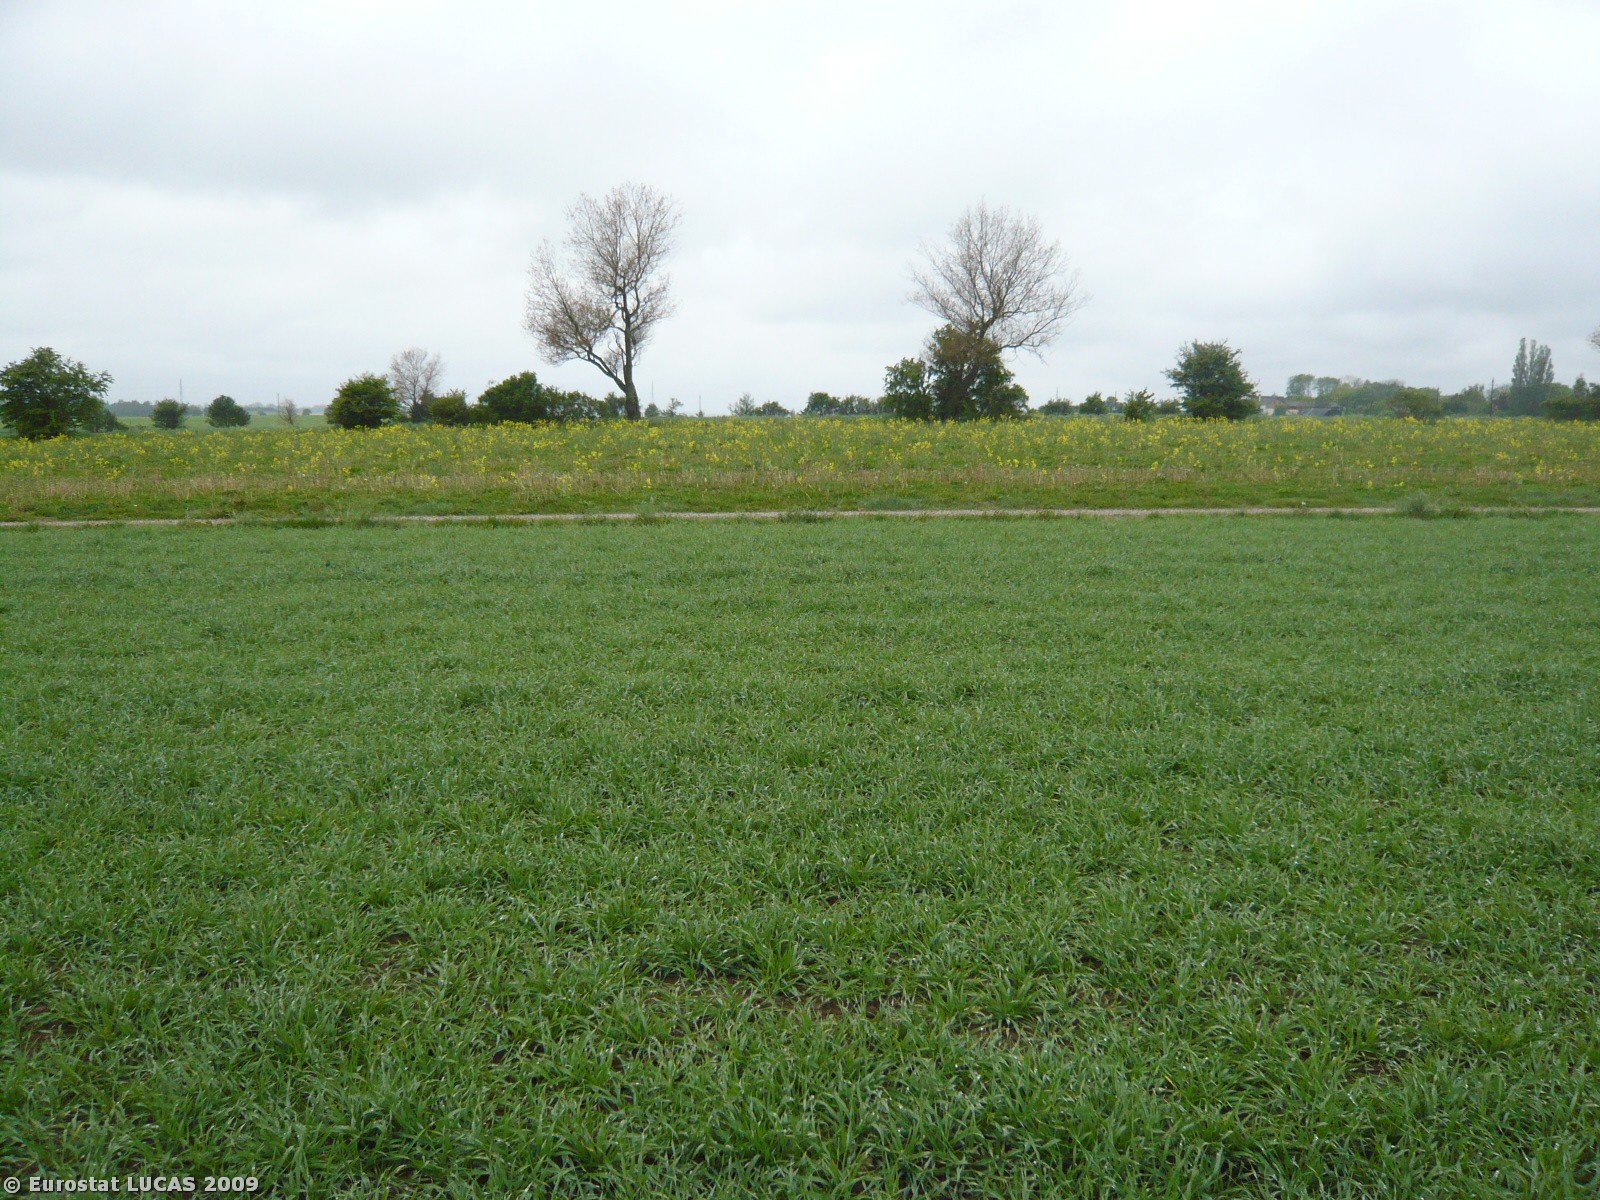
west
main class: Cropland
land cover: Barley
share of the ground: > 75 %
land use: Agriculture (excluding fallow land and kitchen gardens)
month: May
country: DK
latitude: 55.1319
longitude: 11.8338
